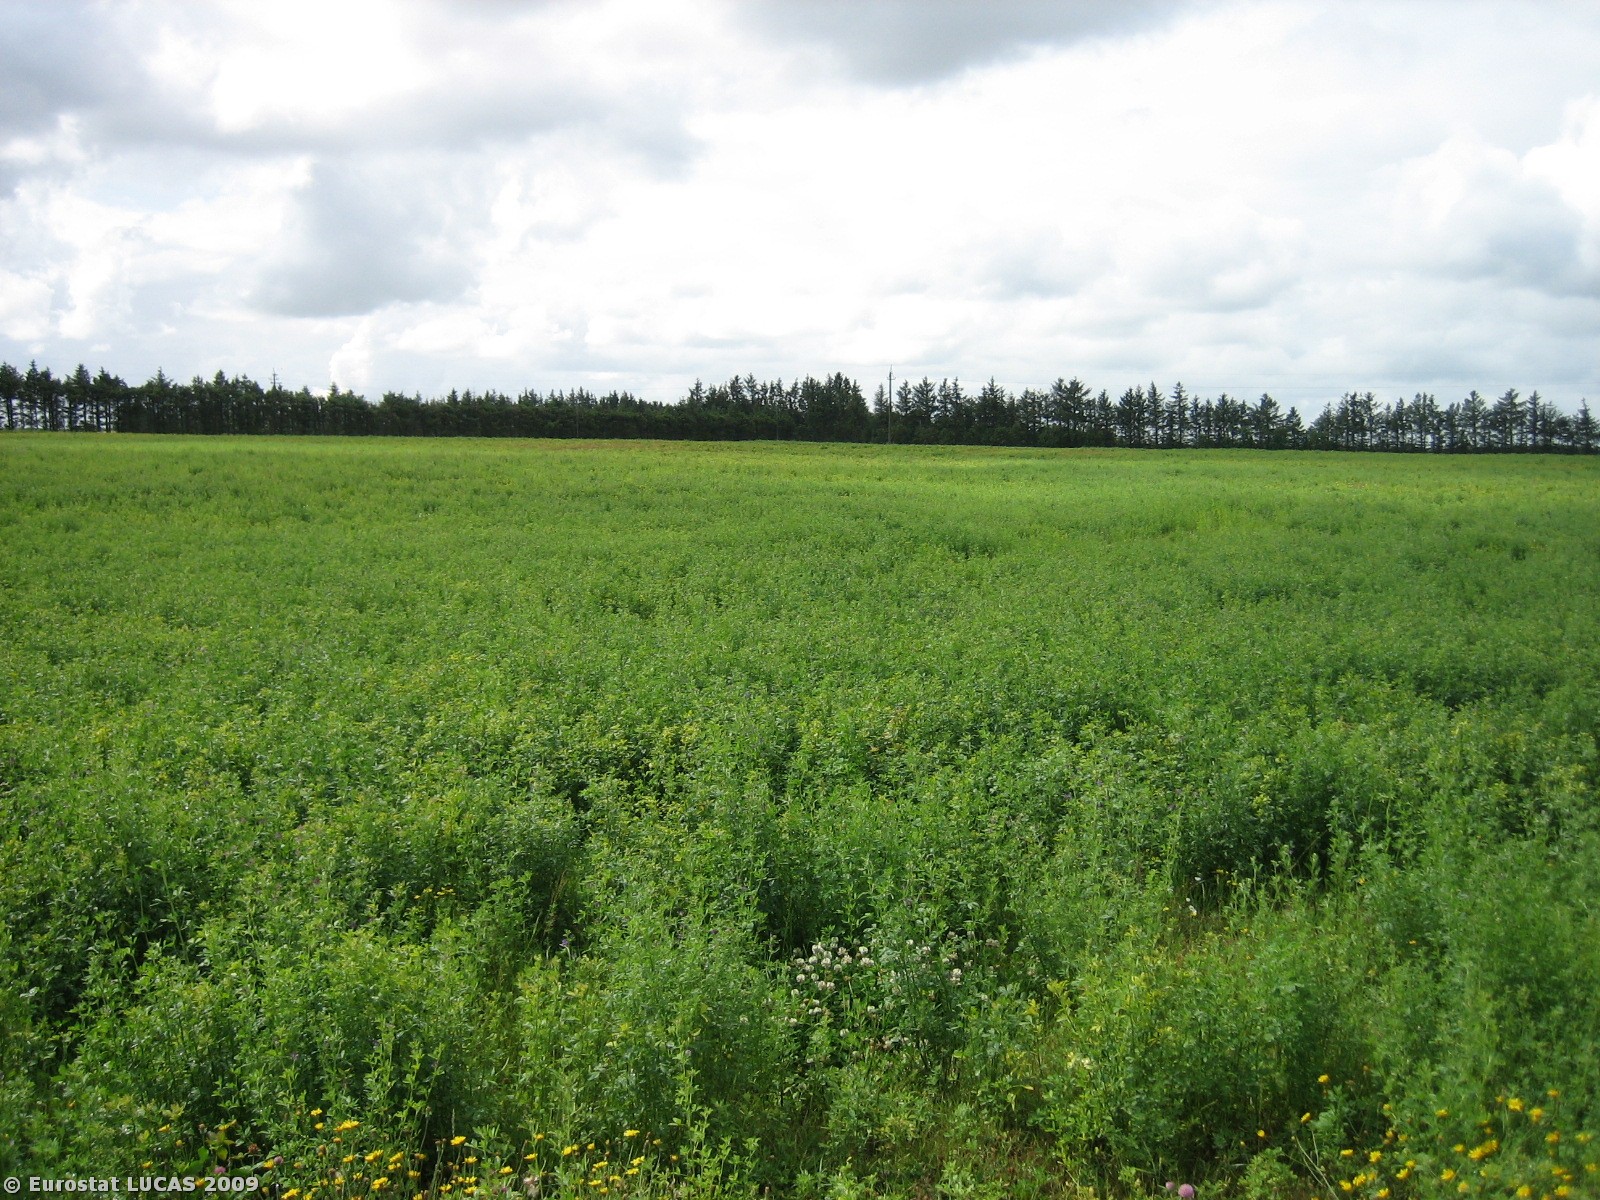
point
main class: Cropland
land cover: Clovers
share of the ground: > 75 %
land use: Agriculture (excluding fallow land and kitchen gardens)
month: July
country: DK
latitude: 55.8372
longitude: 8.4846
